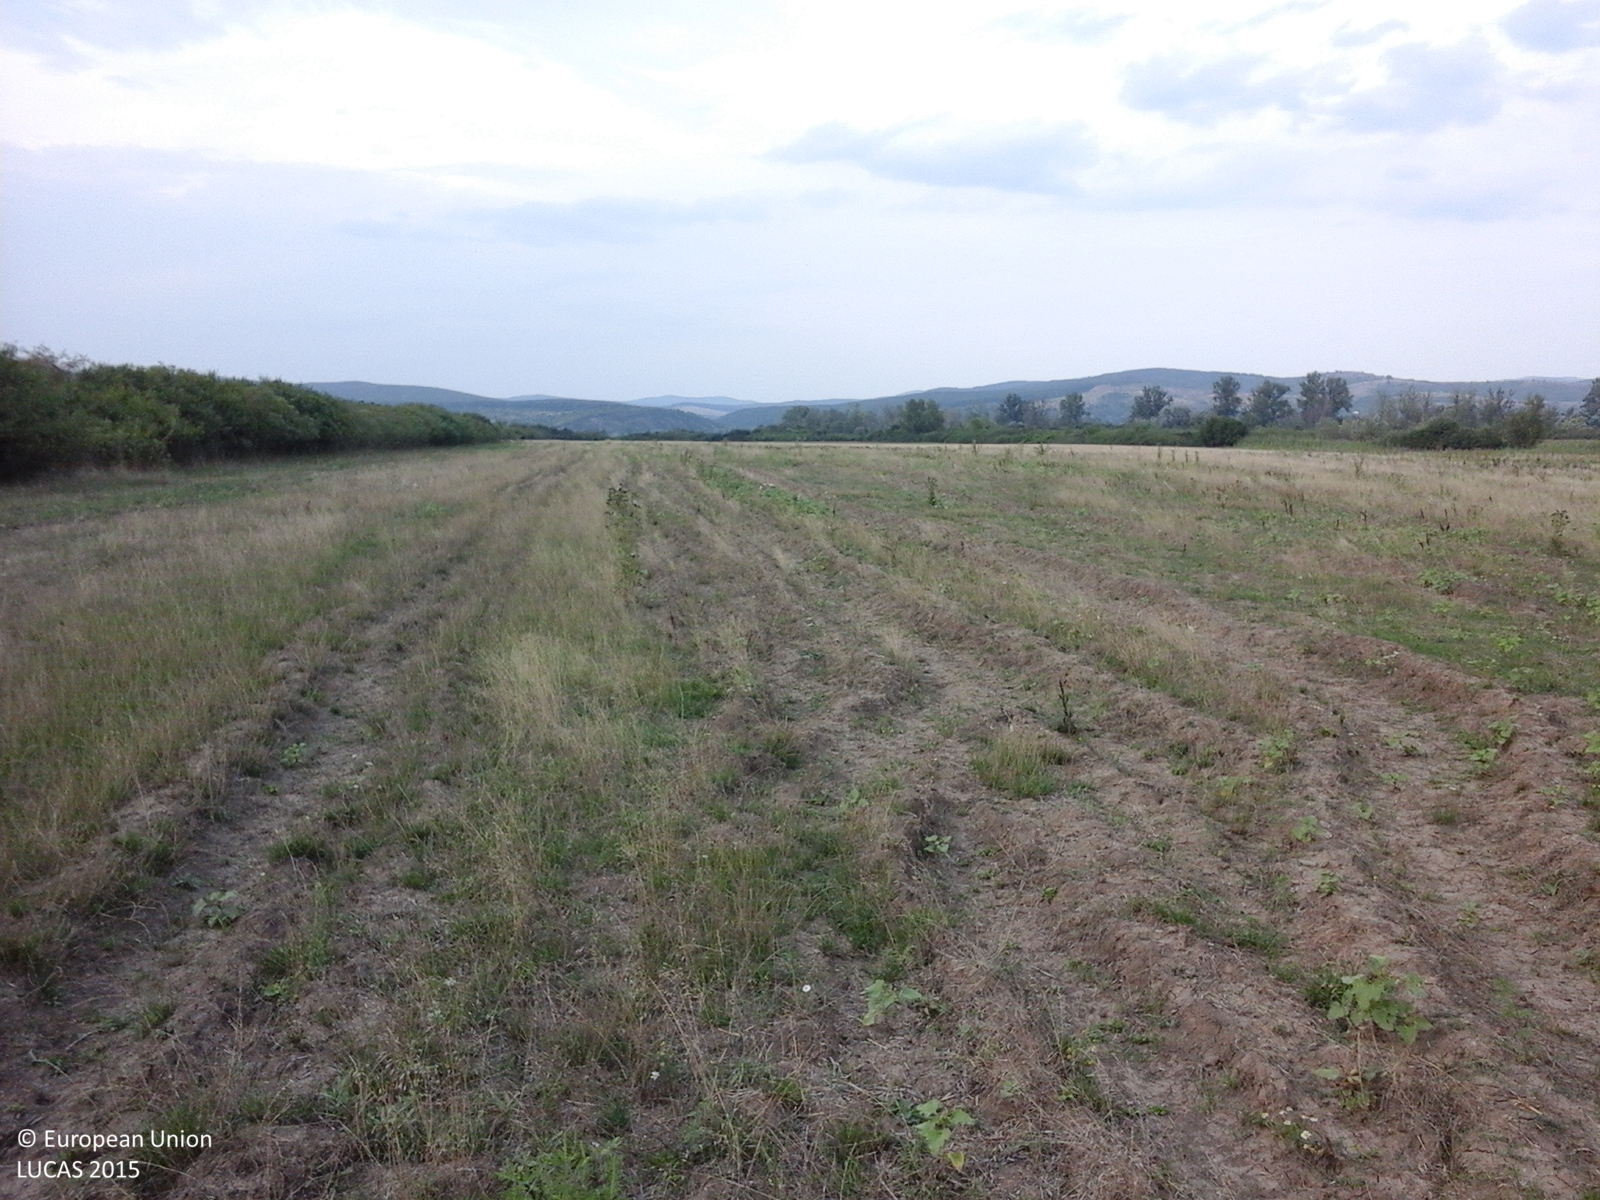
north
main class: Grassland
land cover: Spontaneously vegetated surfaces
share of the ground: > 75 %
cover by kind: herbaceous plants 90 %, consolidated bare surface 10 %
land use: Fallow land
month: August
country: RO
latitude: 46.0776
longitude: 21.6359
